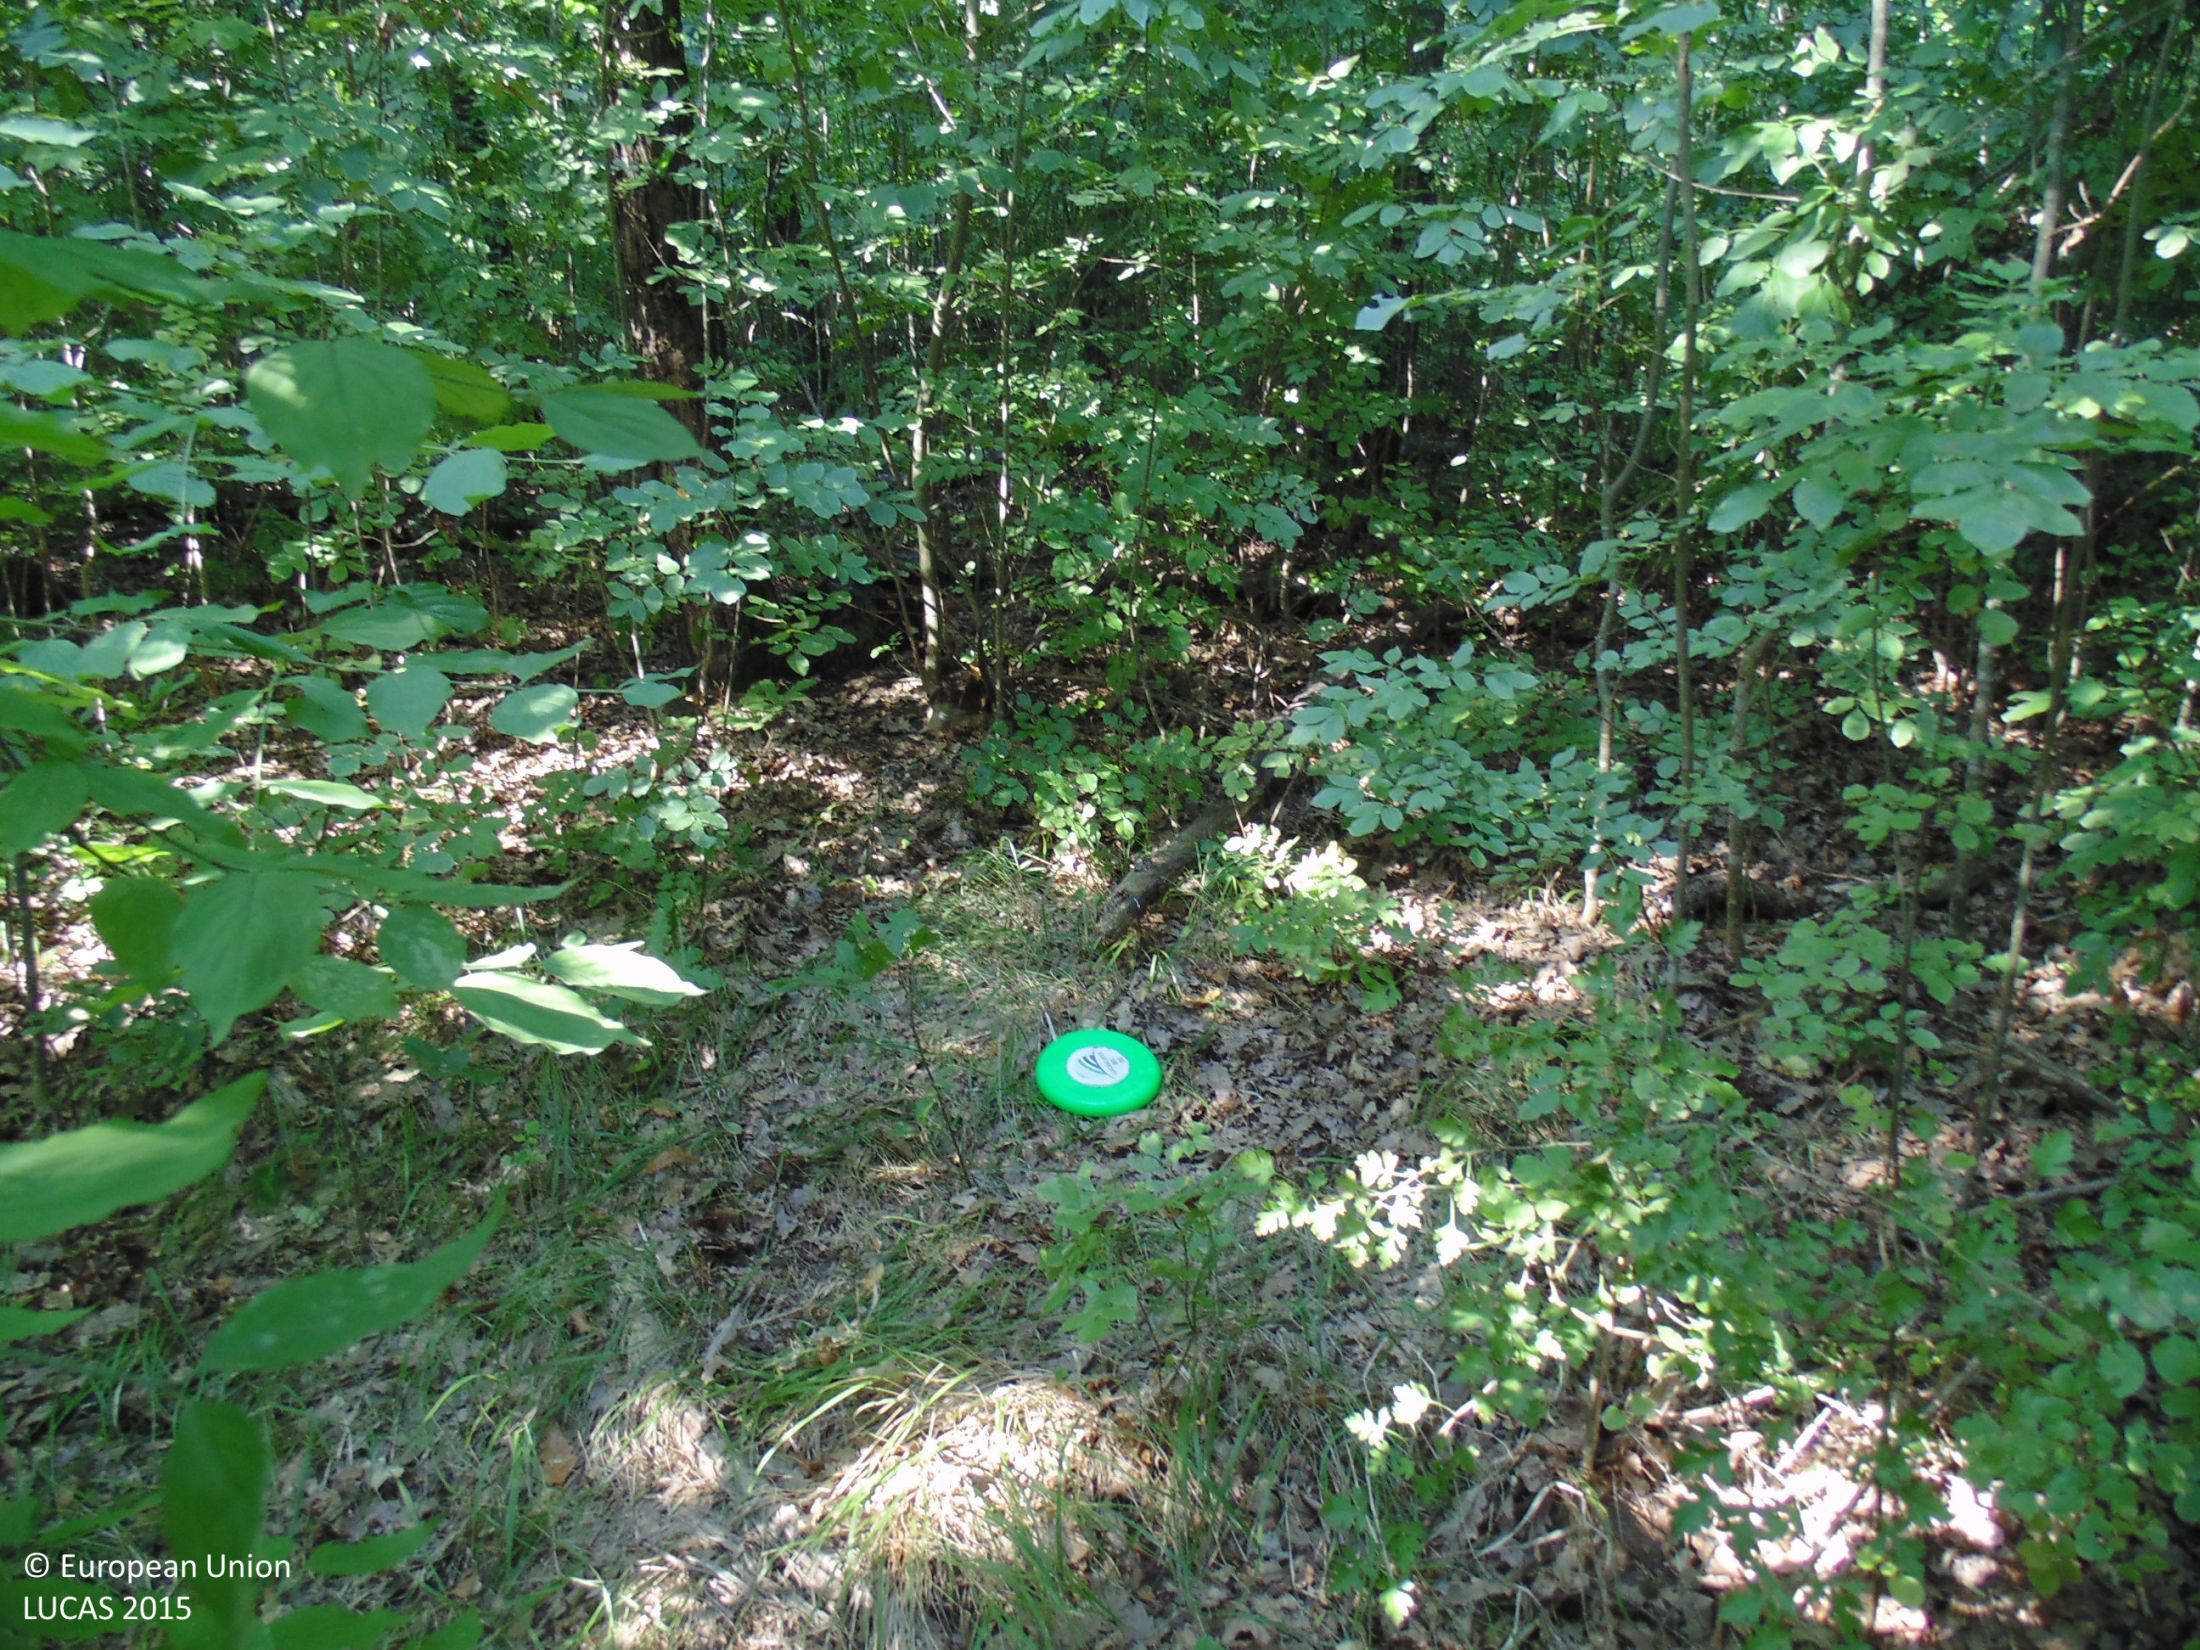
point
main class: Woodland
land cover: Broadleaved woodland
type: mesophytic deciduous forest
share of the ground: > 75 %
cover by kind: broadleaved forest trees 90 %, shrubs 5 %, unconsolidated bare surface 5 %
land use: Forestry
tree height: > 5 m
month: August
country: BG
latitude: 43.8463
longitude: 27.4871
